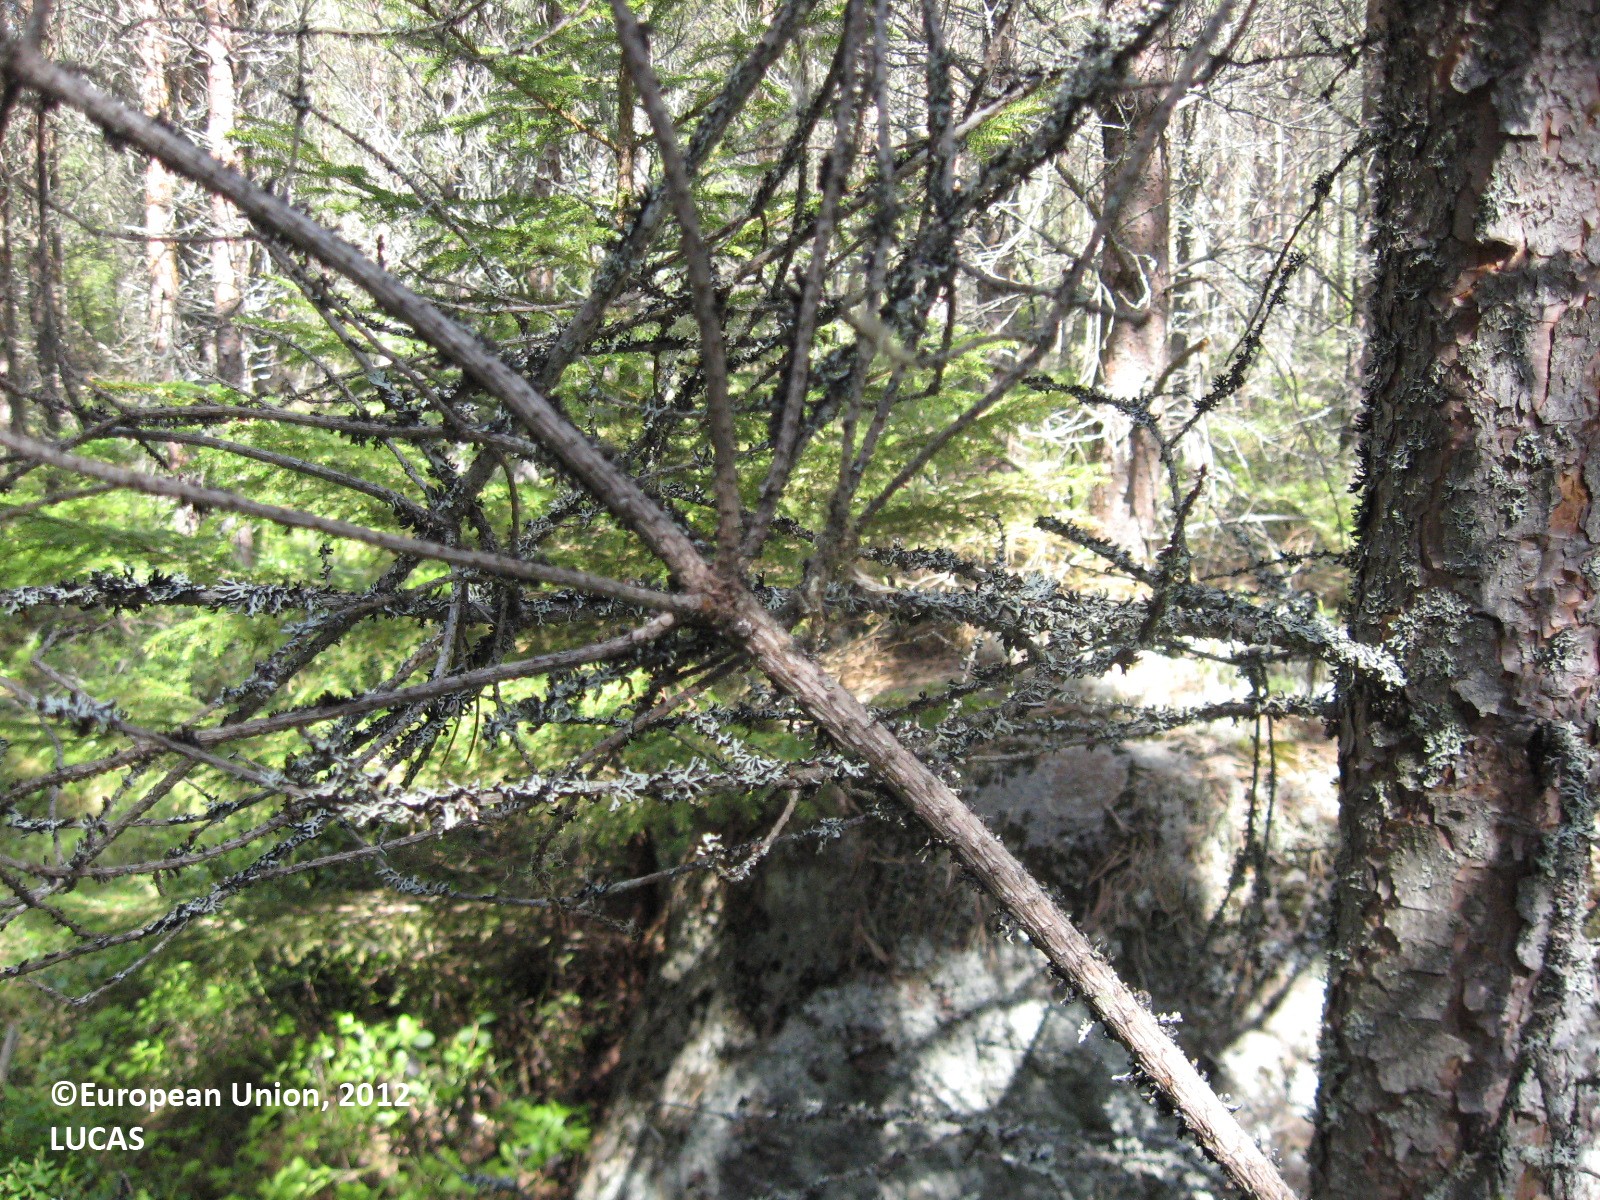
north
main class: Woodland
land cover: Pine dominated coniferous woodland
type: boreal forest
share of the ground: > 75 %
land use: Forestry
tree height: > 5 m
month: June
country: FI
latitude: 63.2161
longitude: 21.4346
